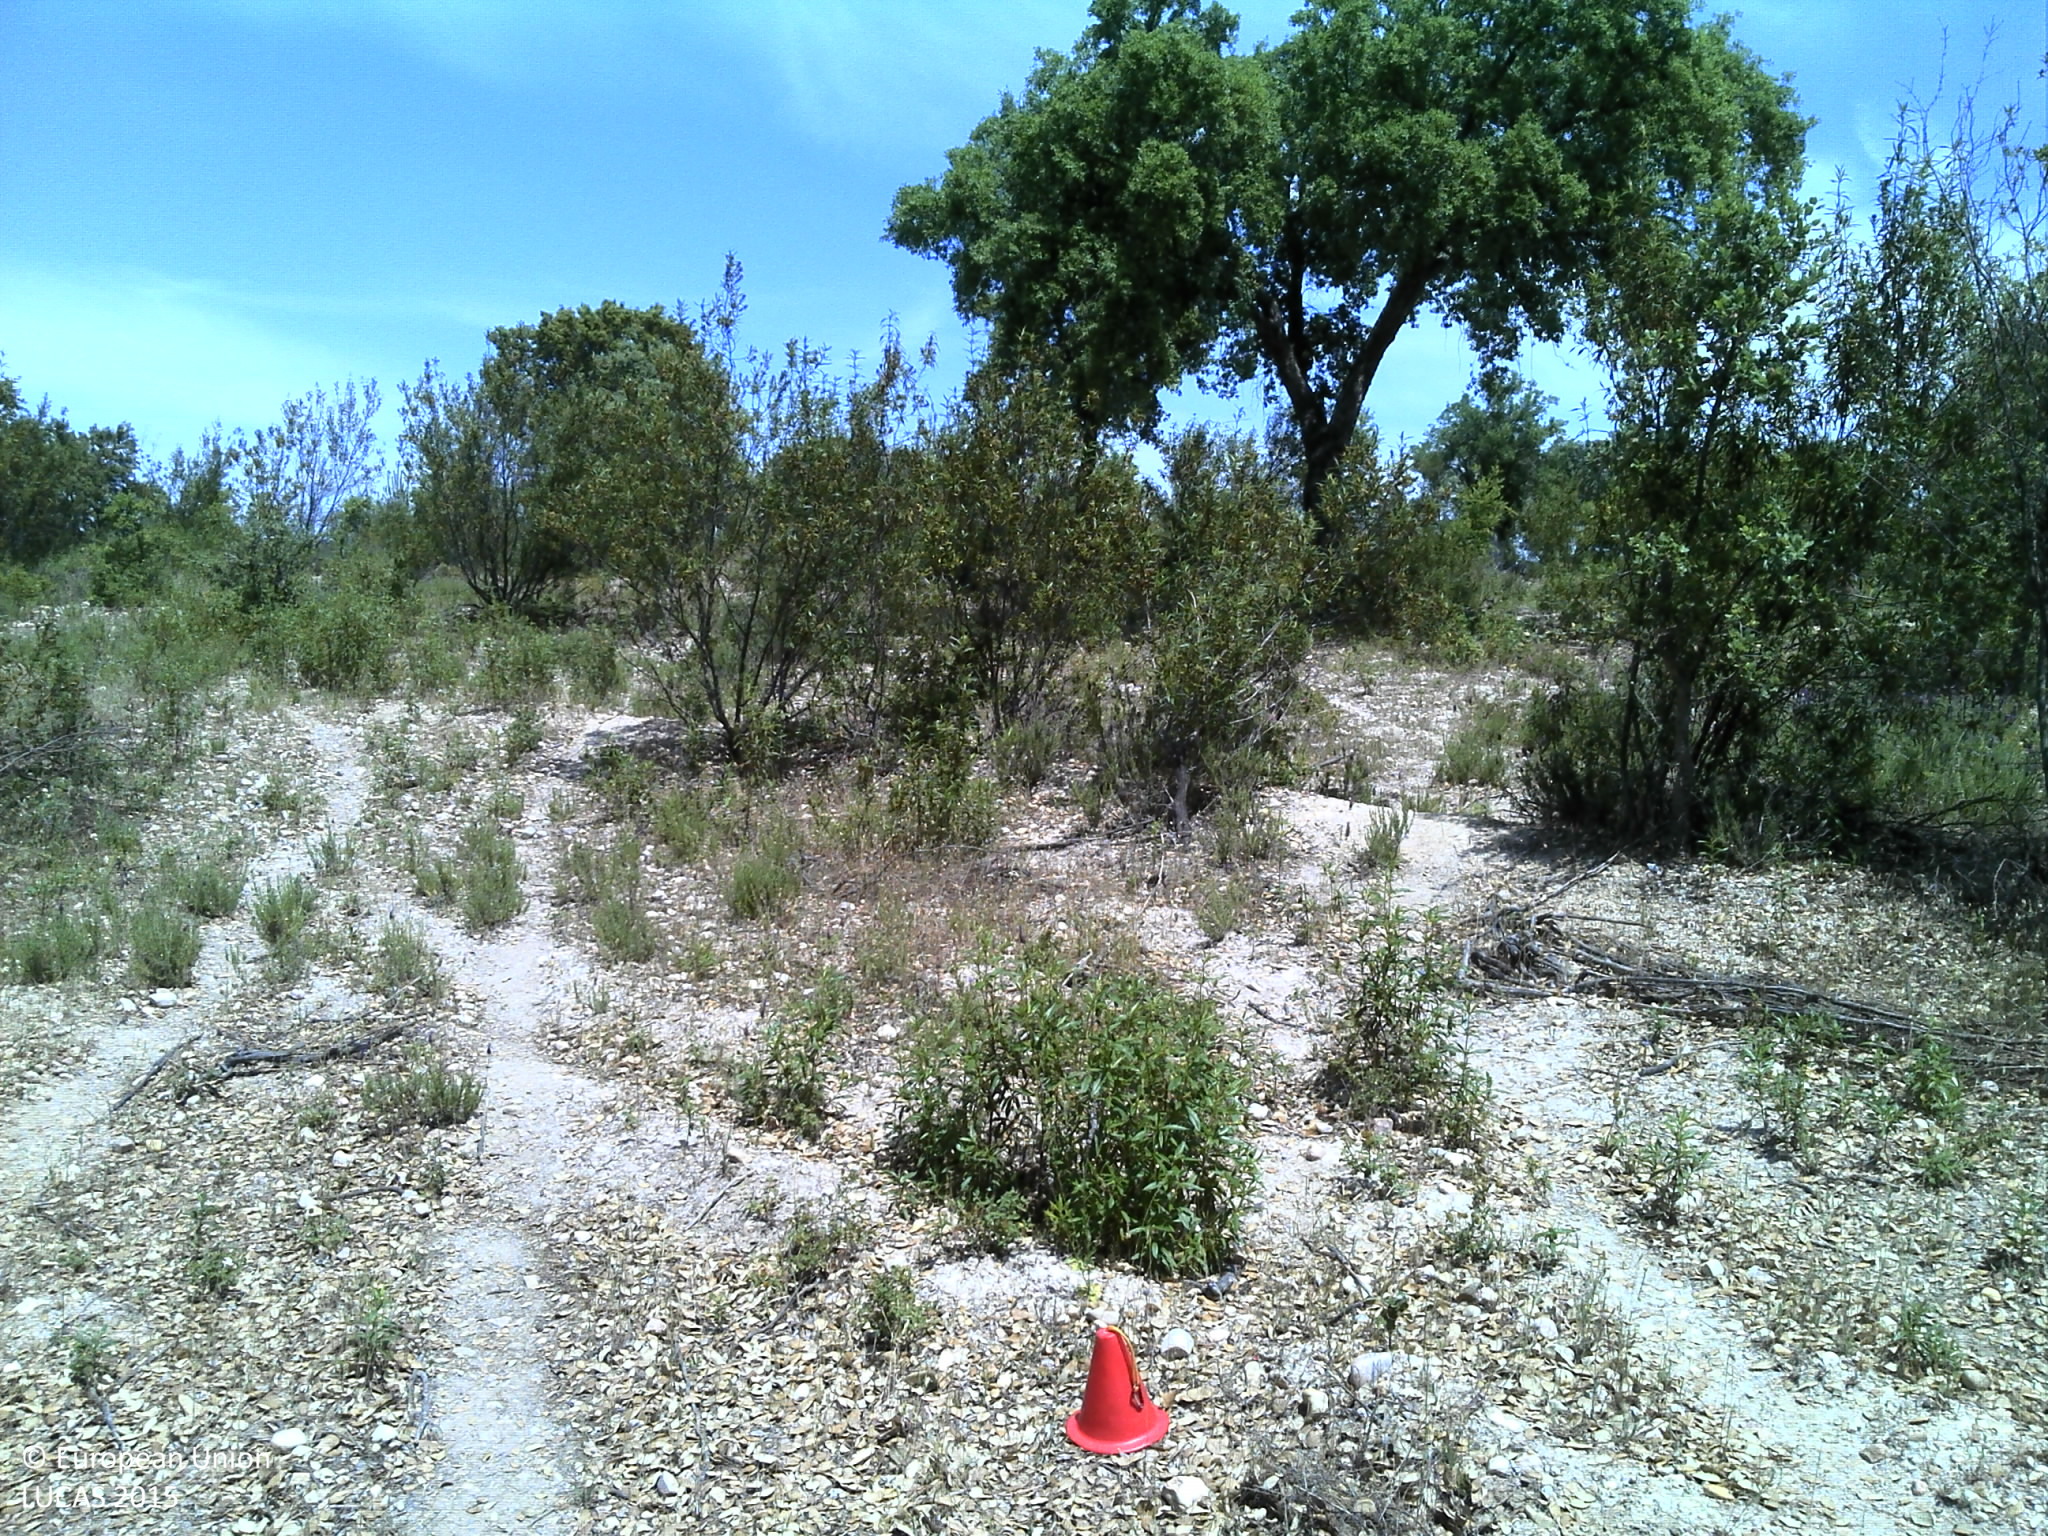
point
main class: Woodland
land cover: Broadleaved woodland
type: broadleaved evergreen forest
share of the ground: 25 - 50 %
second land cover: Grassland without tree/shrub cover
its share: 10 - 25 %
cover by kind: broadleaved forest trees 40 %, herbaceous plants 30 %, unconsolidated bare surface 20 %, shrubs 10 %
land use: Forestry
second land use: Agriculture (excluding fallow land and kitchen gardens)
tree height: > 5 m
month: May
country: PT
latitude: 39.2334
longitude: -7.9041
